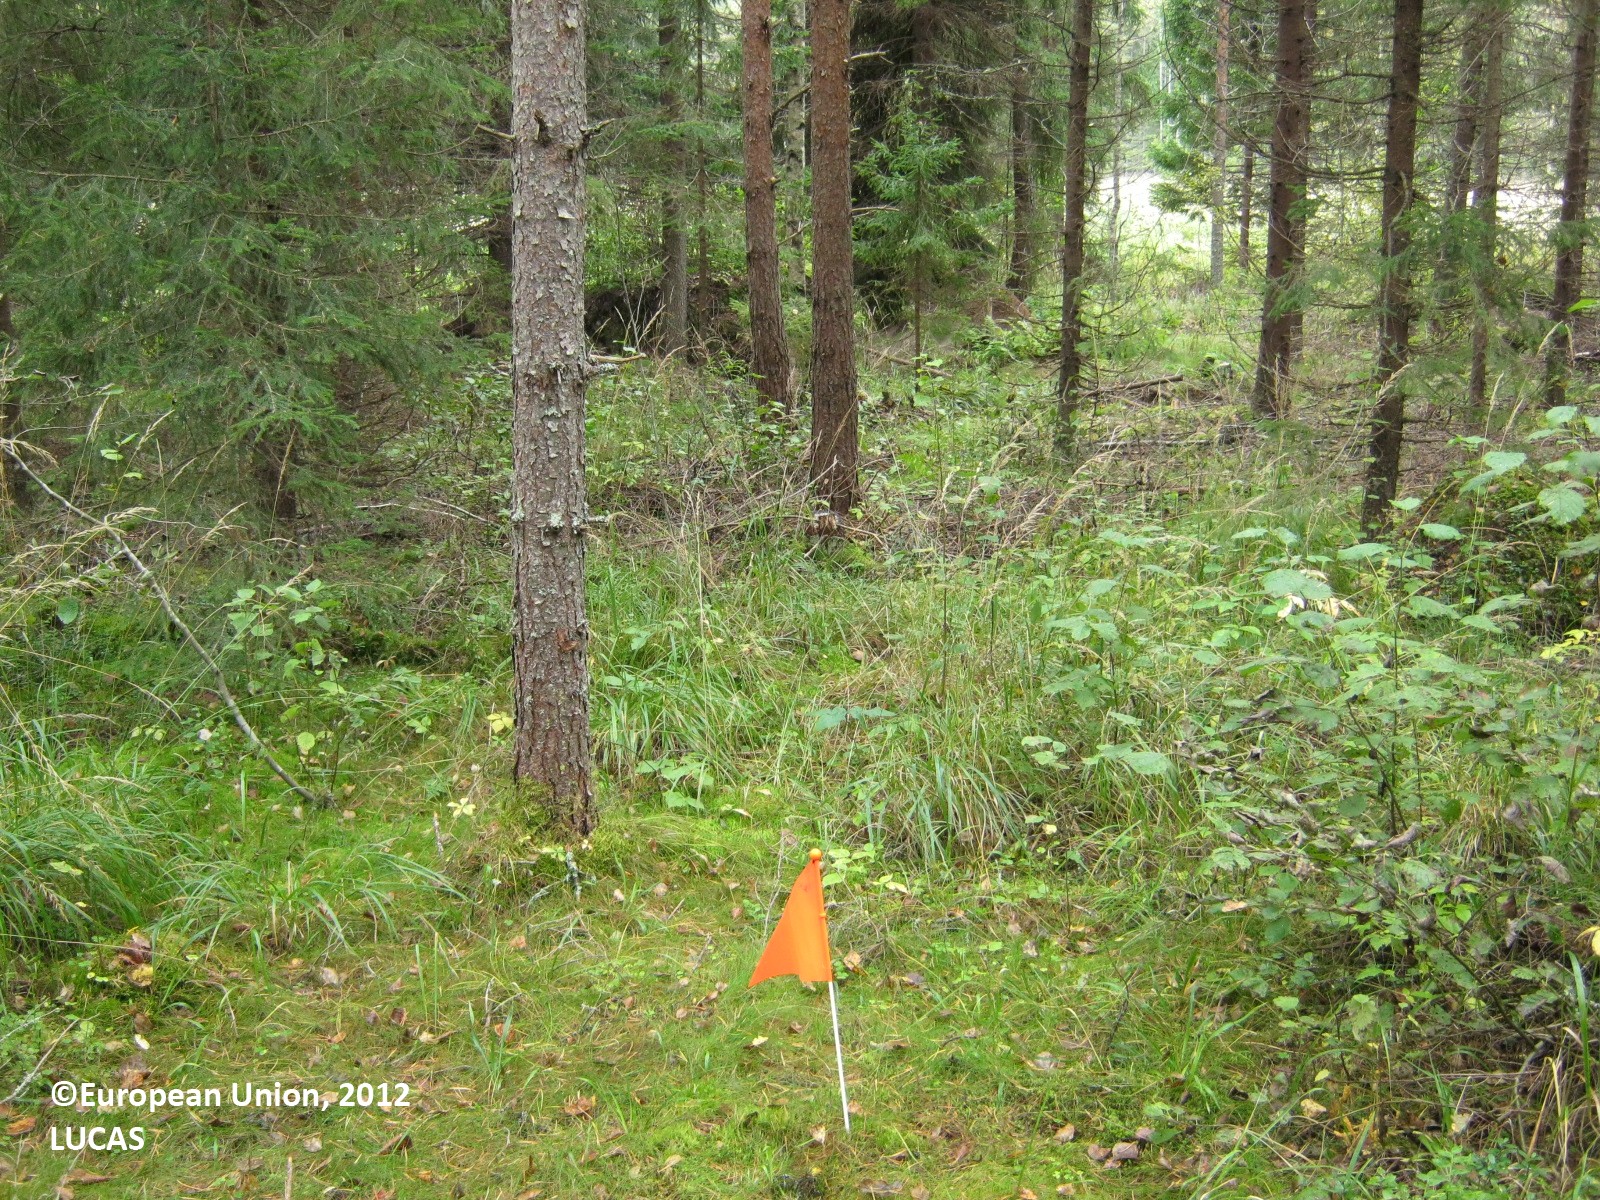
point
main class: Woodland
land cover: Other coniferous woodland
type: boreal forest
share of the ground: 50 - 75 %
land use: Forestry
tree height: > 5 m
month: September
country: FI
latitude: 60.8154
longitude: 27.6350
